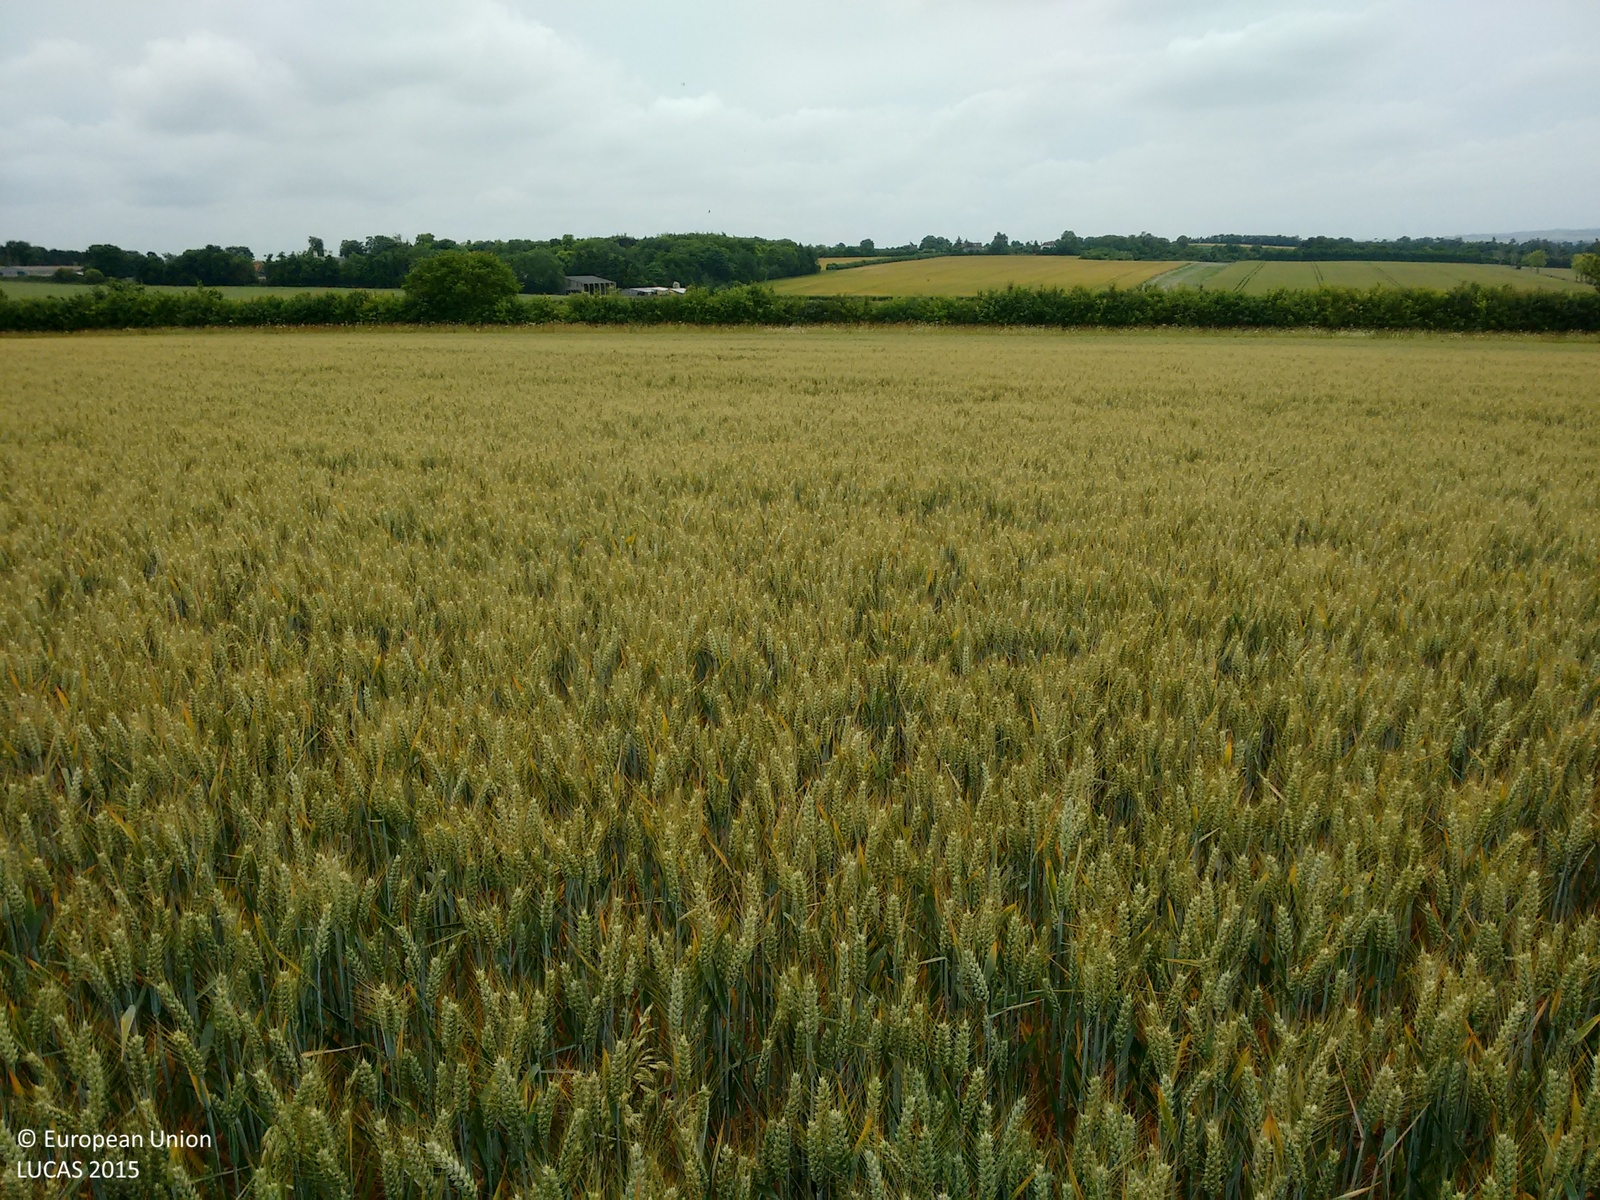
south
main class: Cropland
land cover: Common wheat
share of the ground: > 75 %
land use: Agriculture (excluding fallow land and kitchen gardens)
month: July
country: GB
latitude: 51.6019
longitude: -1.0906
